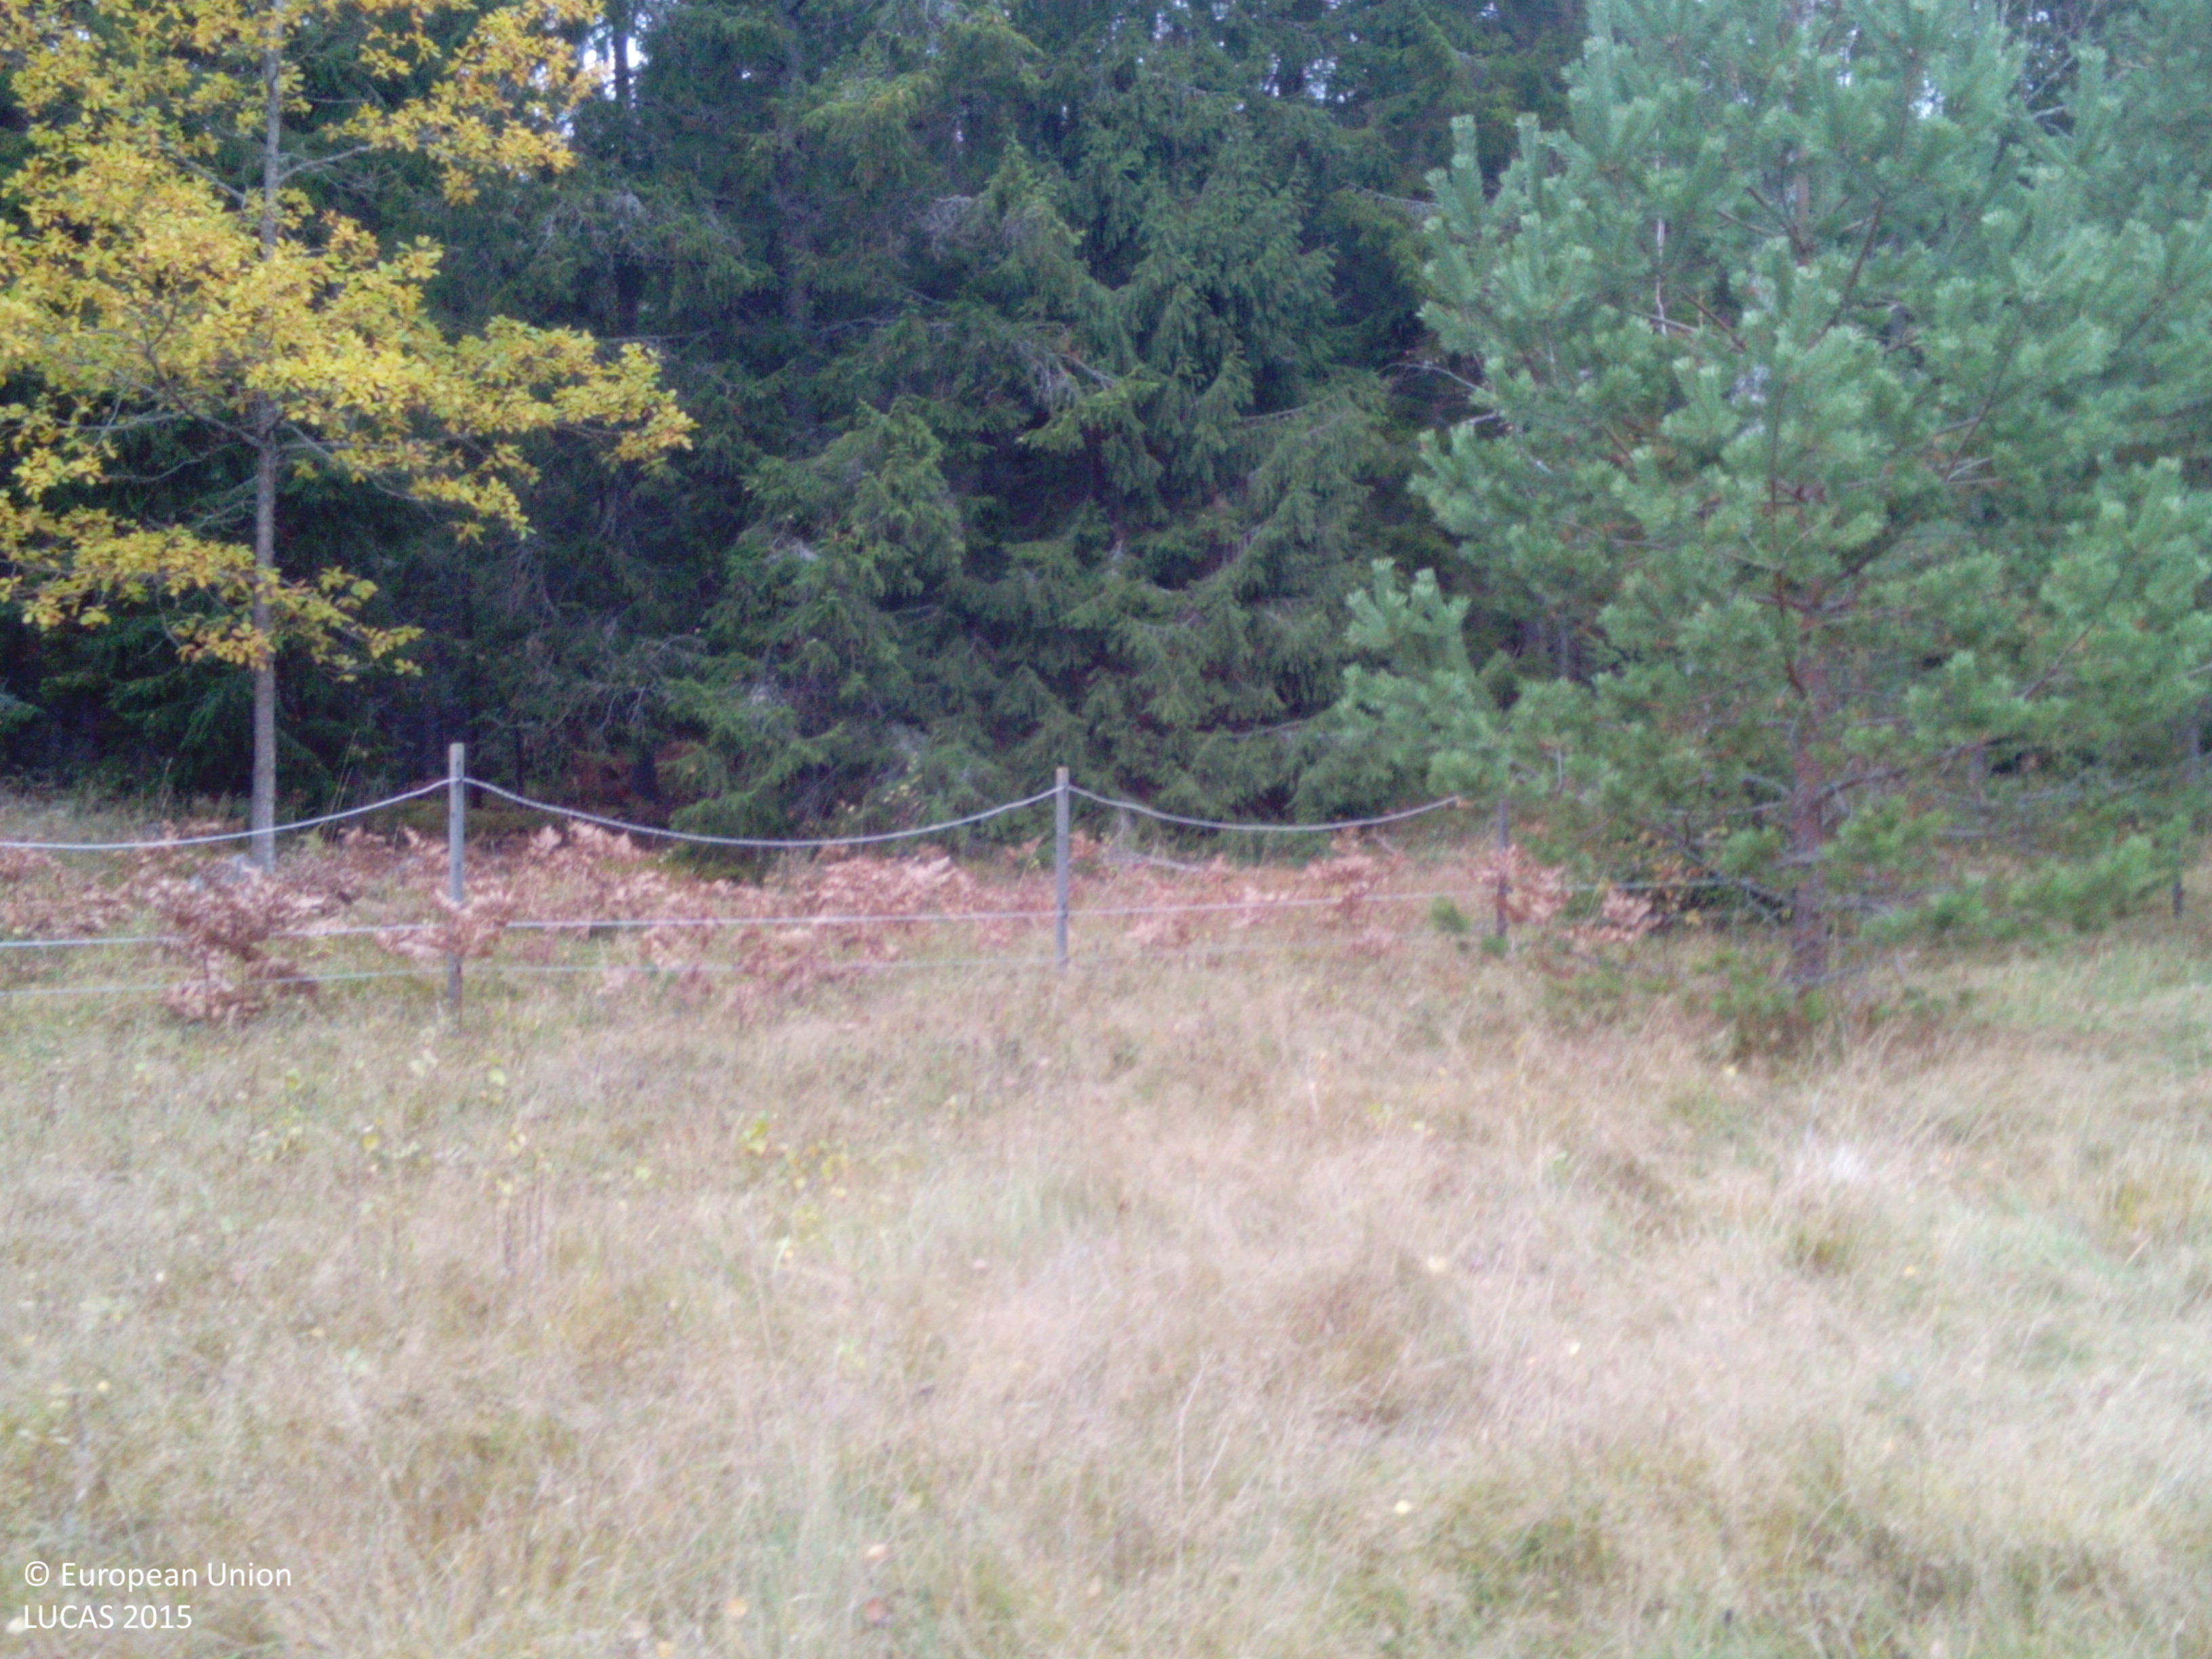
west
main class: Grassland
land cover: Grassland without tree/shrub cover
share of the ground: > 75 %
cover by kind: herbaceous plants 100 %
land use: Agriculture (excluding fallow land and kitchen gardens)
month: October
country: SE
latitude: 59.2474
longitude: 16.2524
